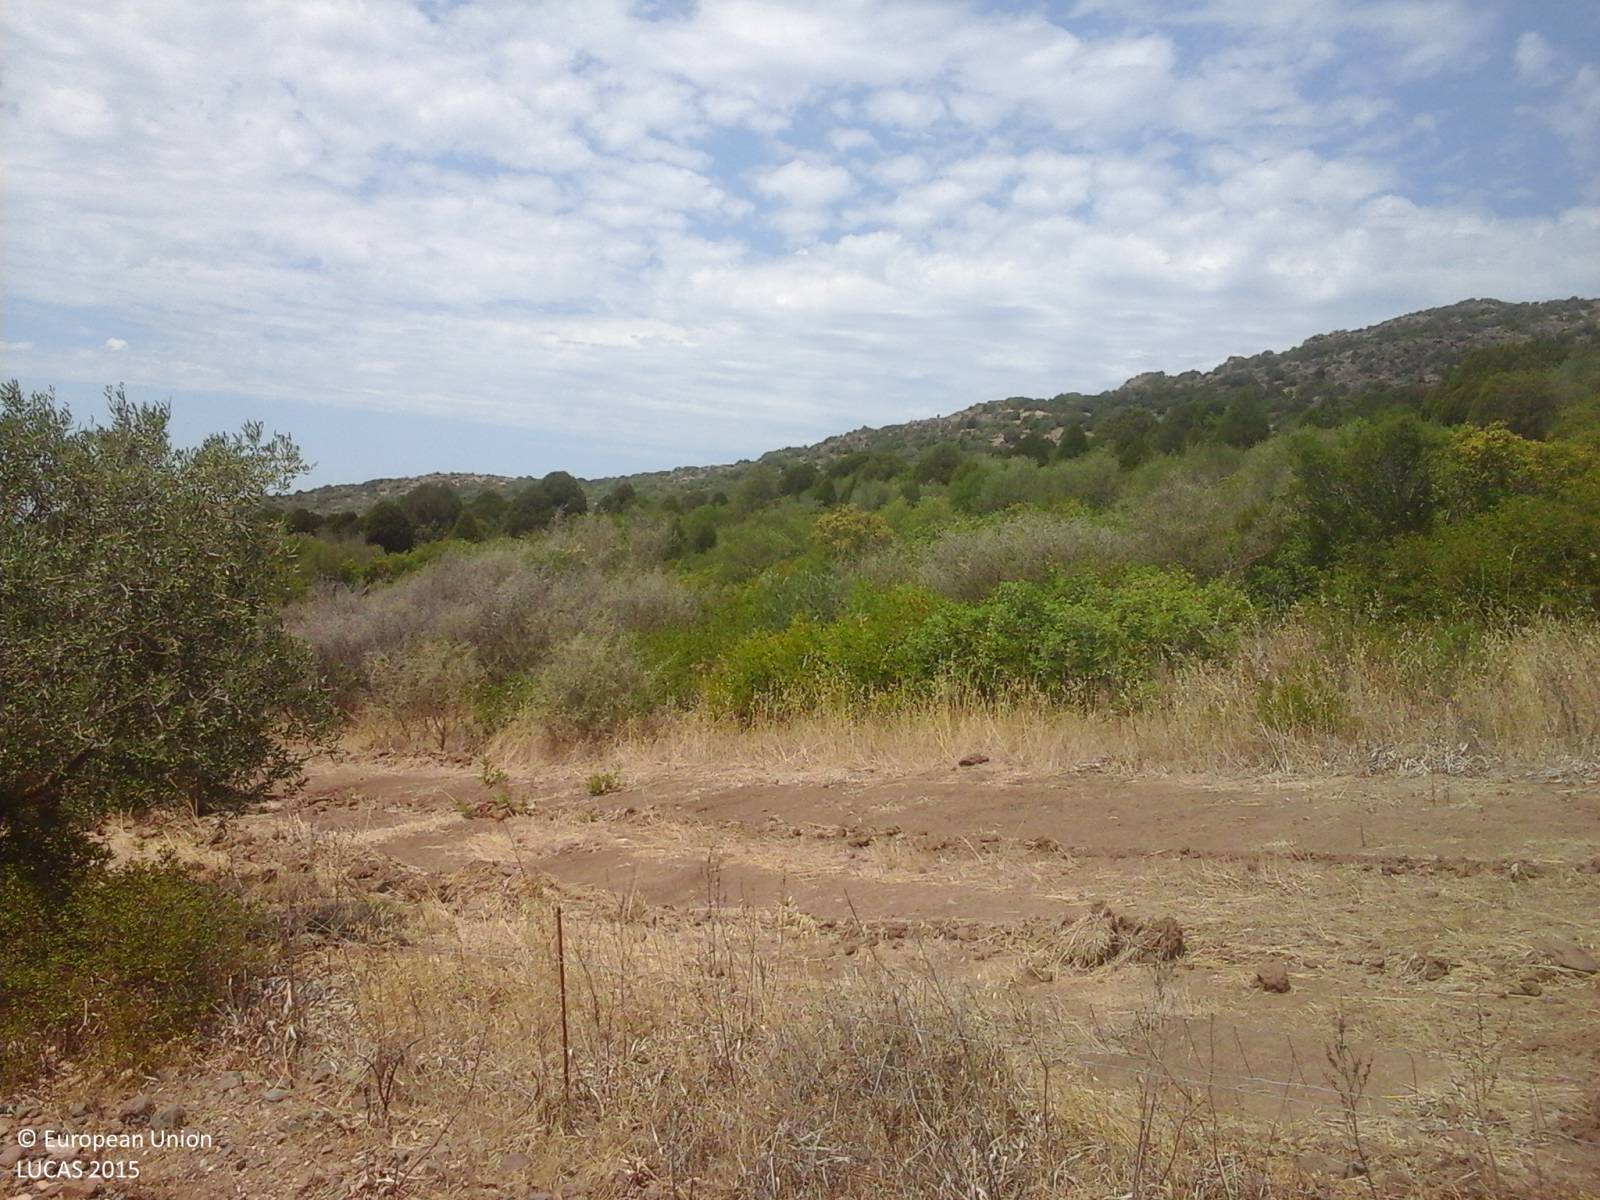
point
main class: Shrubland
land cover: Shrubland with sparse tree cover
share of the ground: > 75 %
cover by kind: shrubs 70 %, unconsolidated bare surface 20 %, broadleaved forest trees 5 %, herbaceous plants 5 %
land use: Agriculture (excluding fallow land and kitchen gardens)
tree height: < 5 m
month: July
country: IT
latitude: 39.1165
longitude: 8.6323
